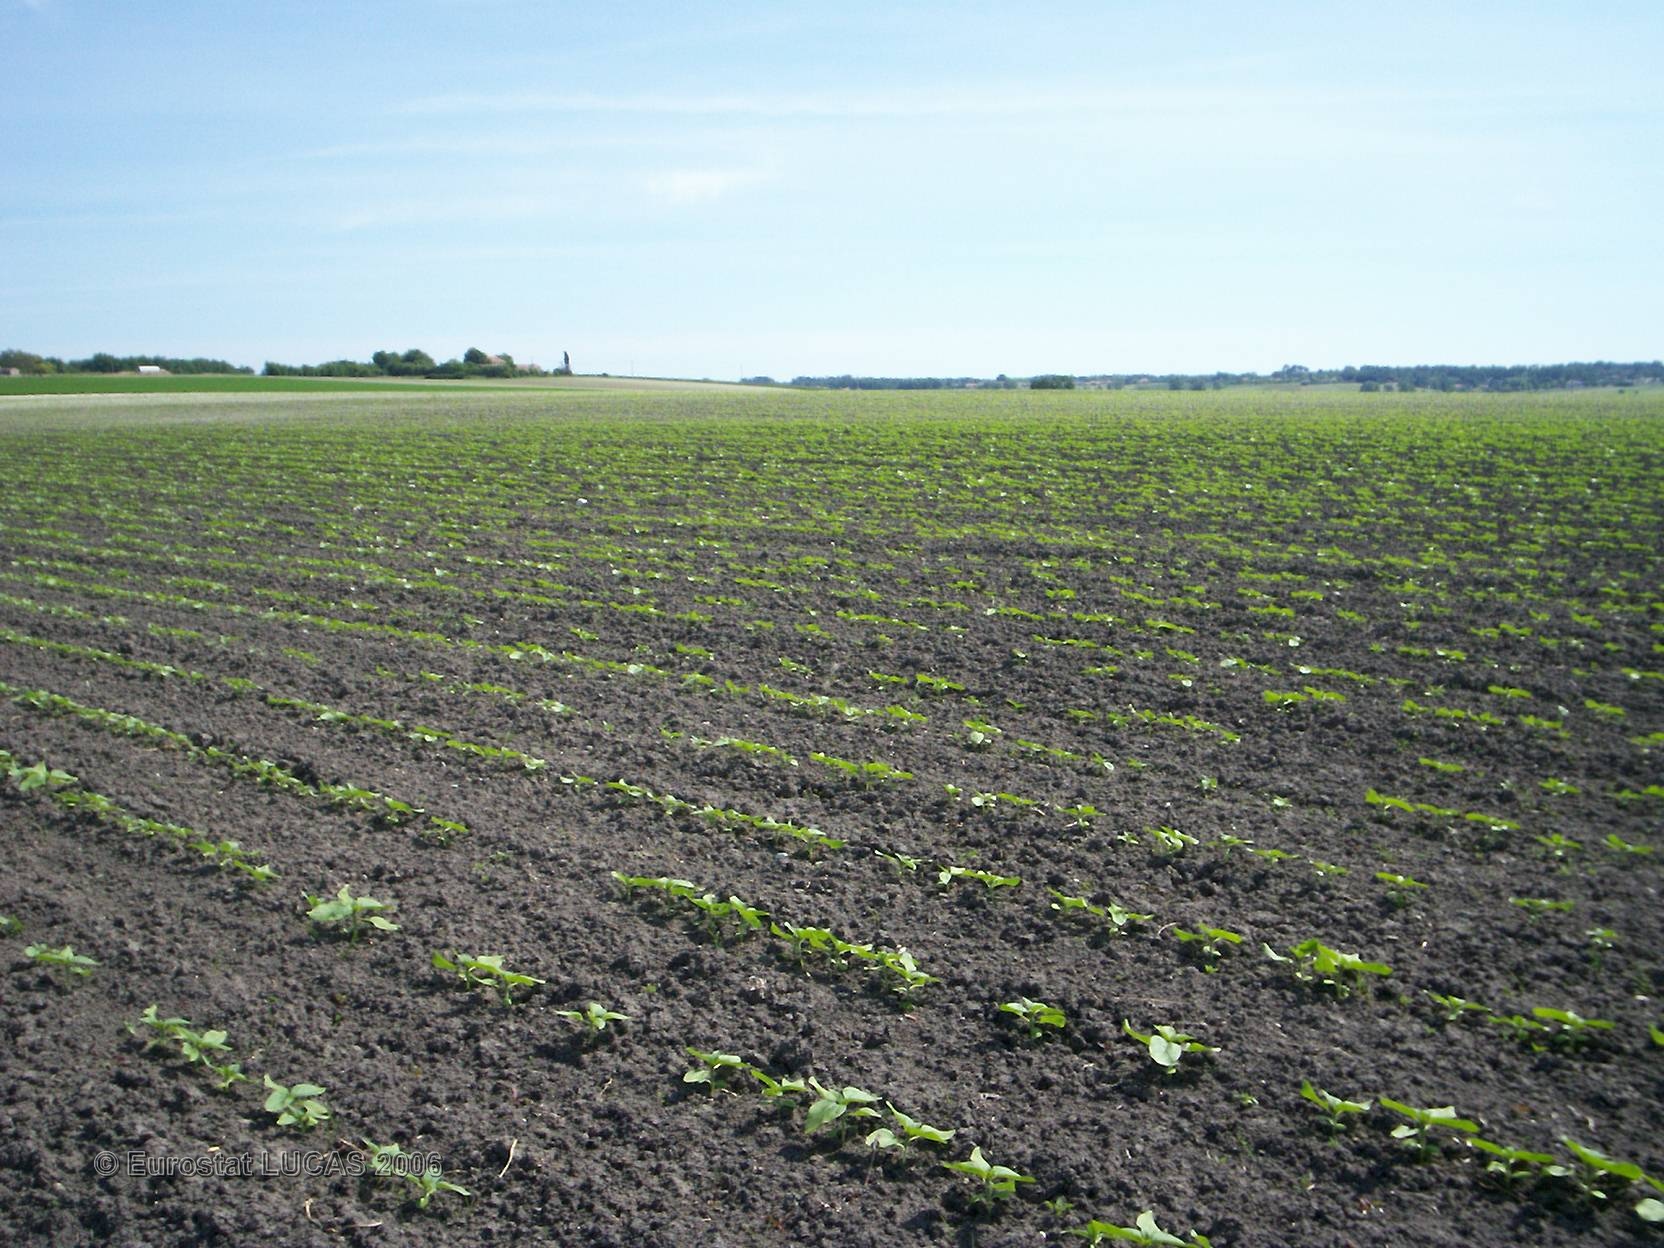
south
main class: Cropland
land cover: Sunflower
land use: Agriculture (excluding fallow land and kitchen gardens)
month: June
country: FR
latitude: 45.7003
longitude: -1.0867
